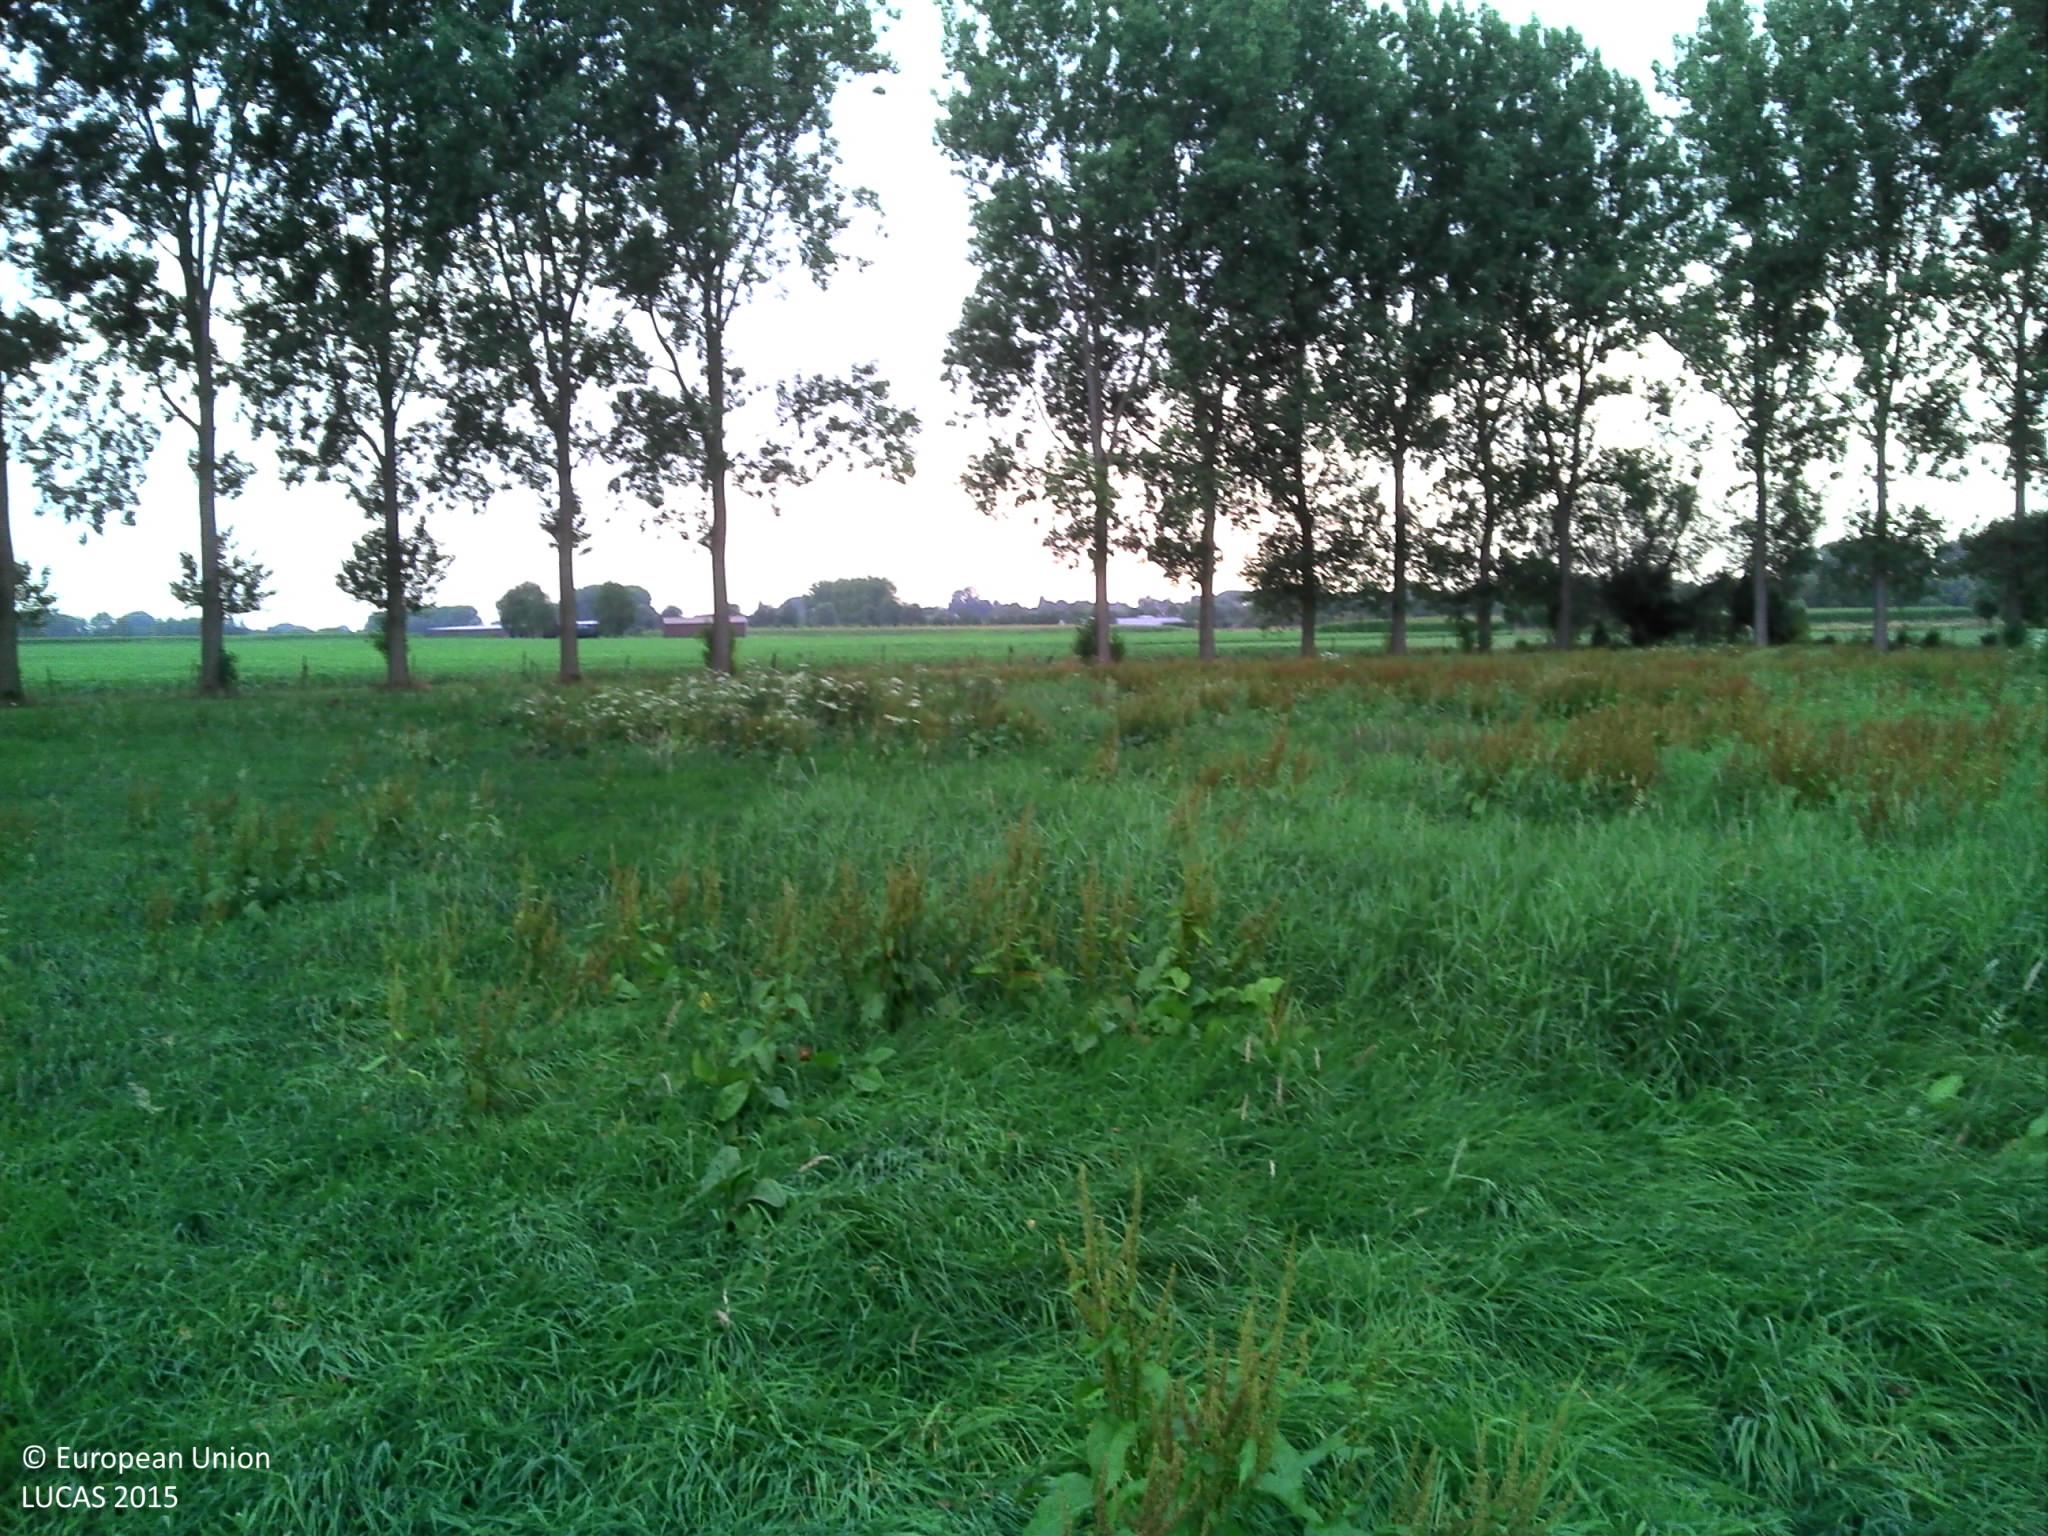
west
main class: Grassland
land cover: Grassland without tree/shrub cover
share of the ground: > 75 %
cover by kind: herbaceous plants 100 %
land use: Agriculture (excluding fallow land and kitchen gardens)
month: August
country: BE
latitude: 50.6653
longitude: 3.8108
